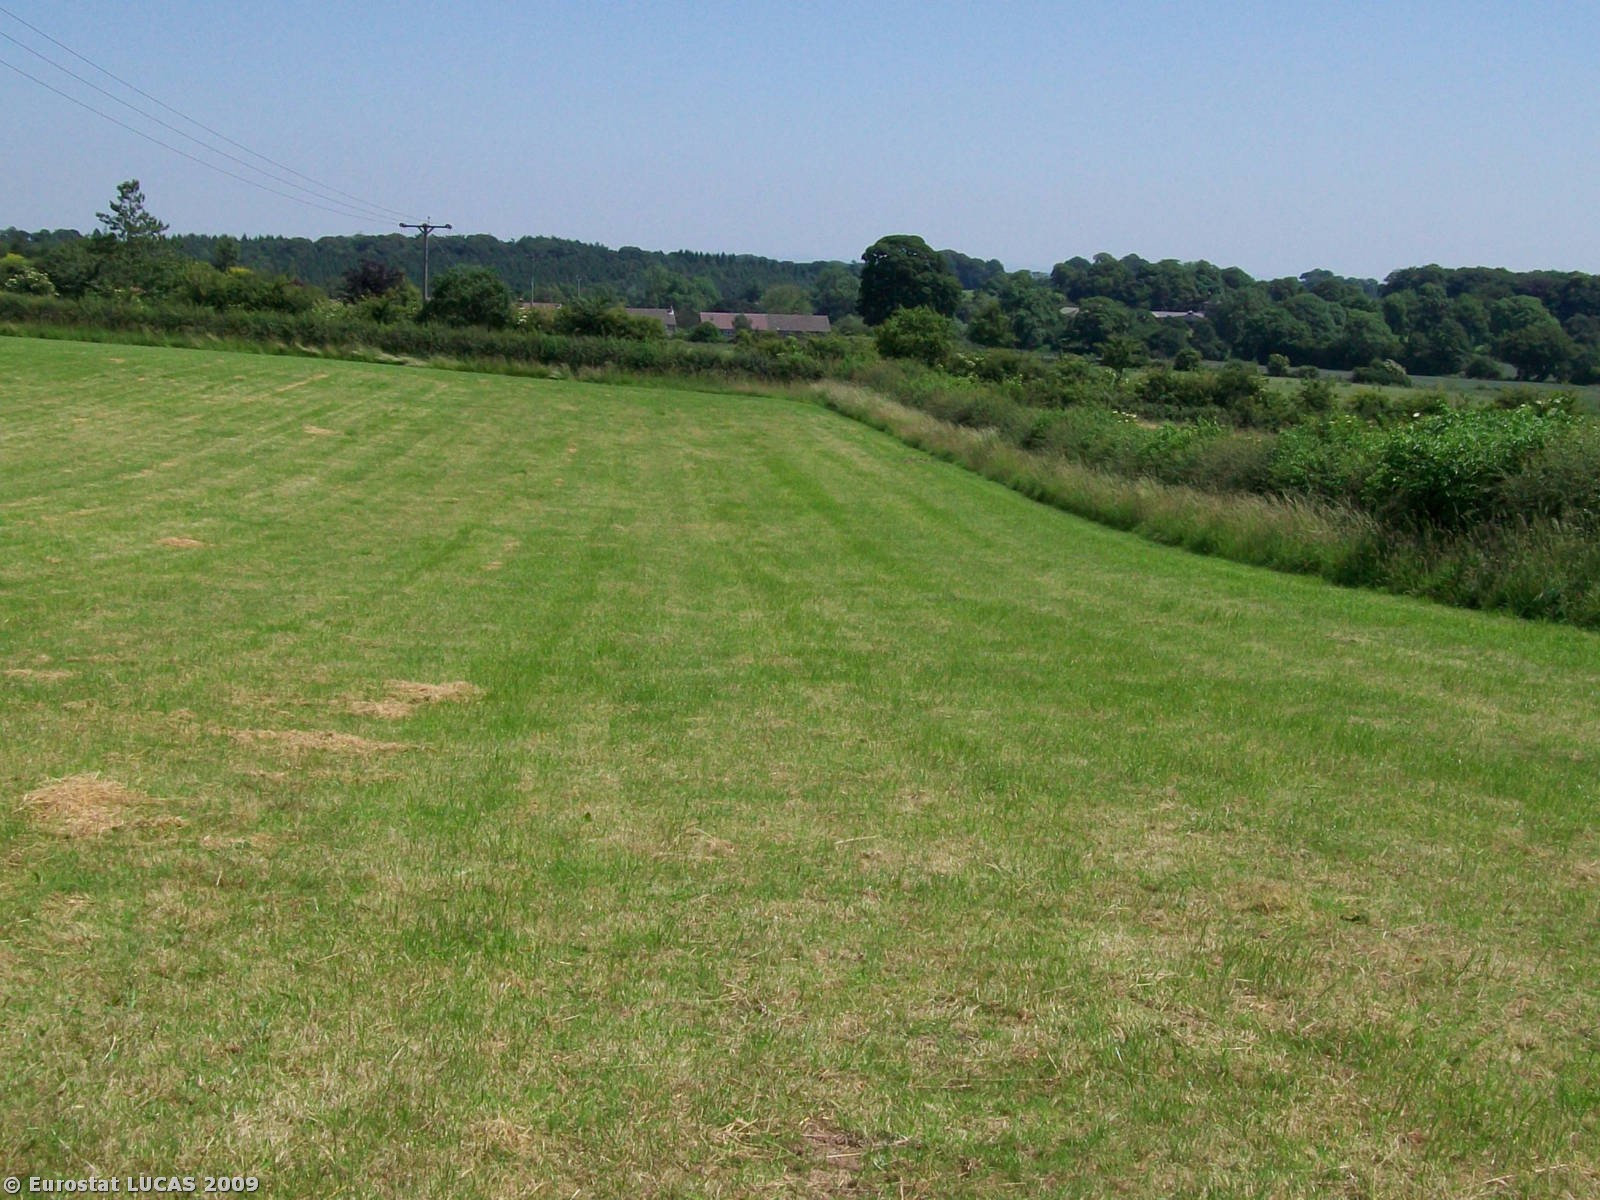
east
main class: Grassland
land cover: Grassland without tree/shrub cover
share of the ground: < 10 %
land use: Agriculture (excluding fallow land and kitchen gardens)
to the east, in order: Grassland without tree/shrub cover; Managed hedges; Grass margins; Barley; Grass margins; Managed hedges; Grass margins; Tracks; Grass margins; Managed hedges; Grassland with sparse tree/shrub cover
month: July
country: GB
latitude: 53.9281
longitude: -1.4557
